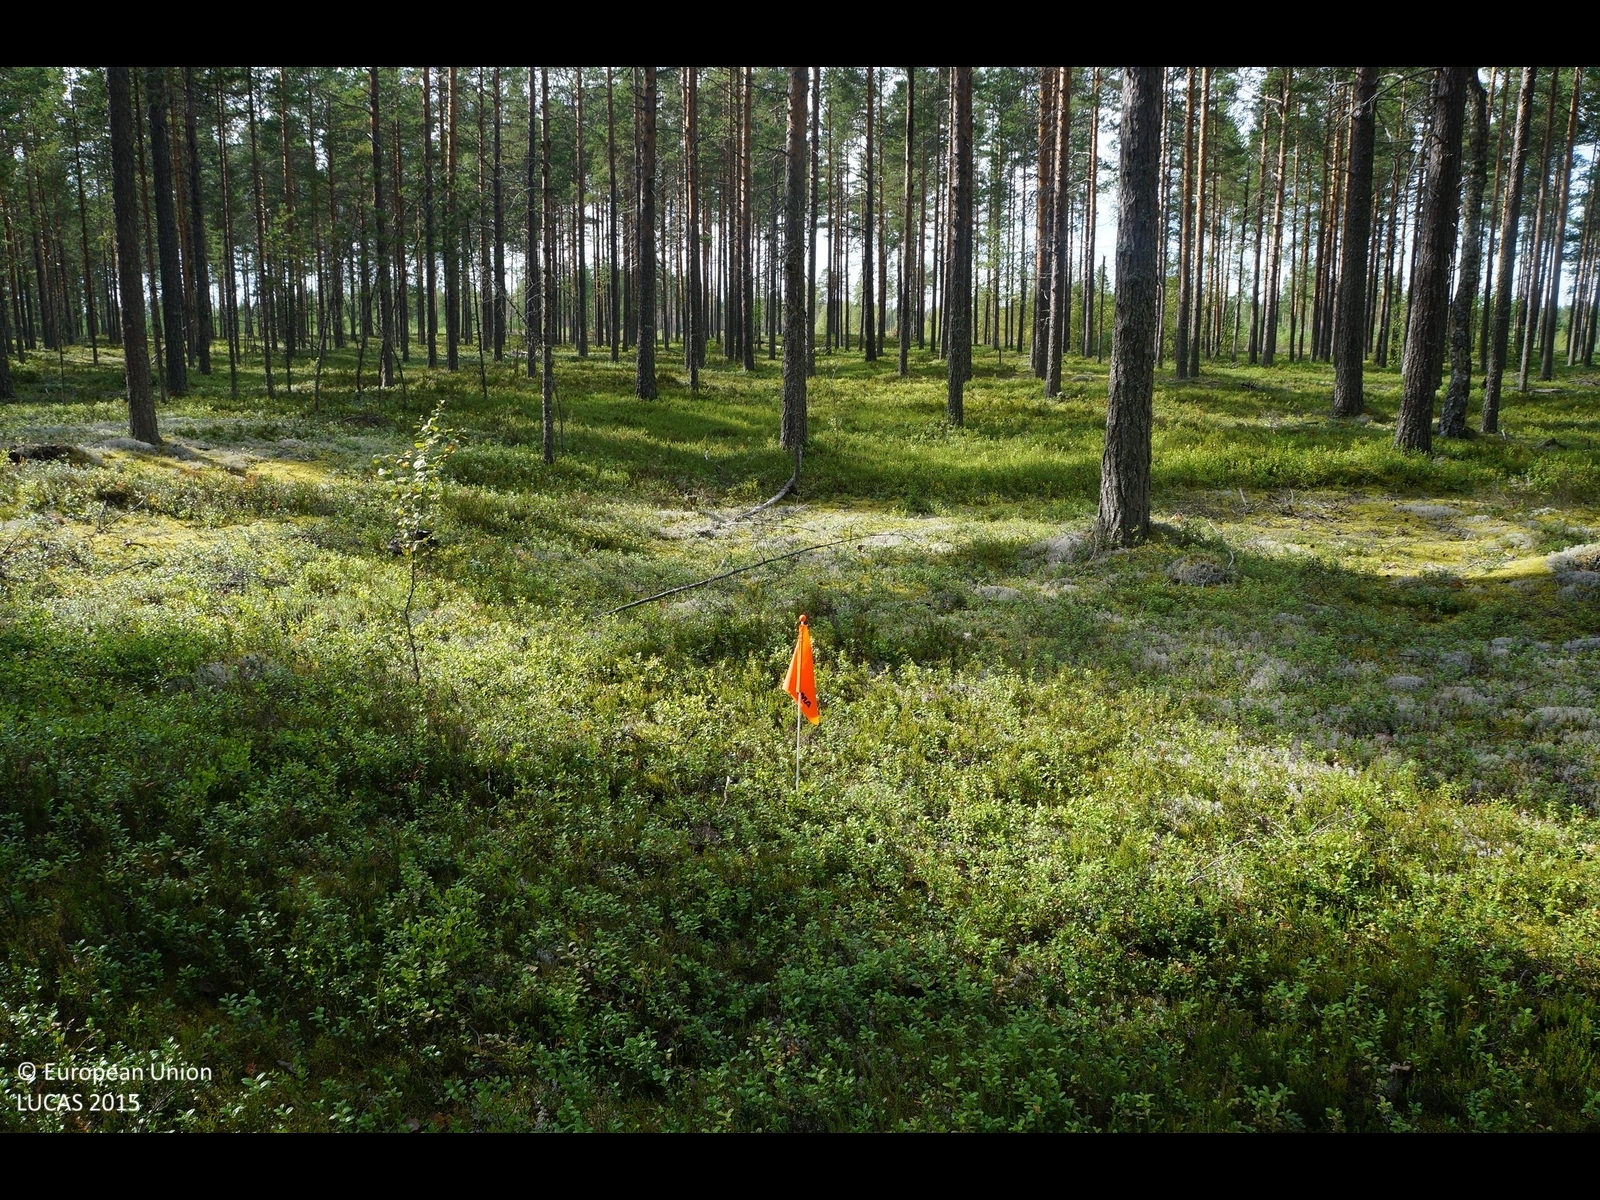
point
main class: Woodland
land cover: Pine dominated coniferous woodland
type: boreal forest
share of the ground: 50 - 75 %
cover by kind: coniferous forest trees 50 %, shrubs 30 %, lichens and mosses 20 %
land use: Forestry
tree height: > 5 m
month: August
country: FI
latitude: 64.5733
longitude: 24.9182
